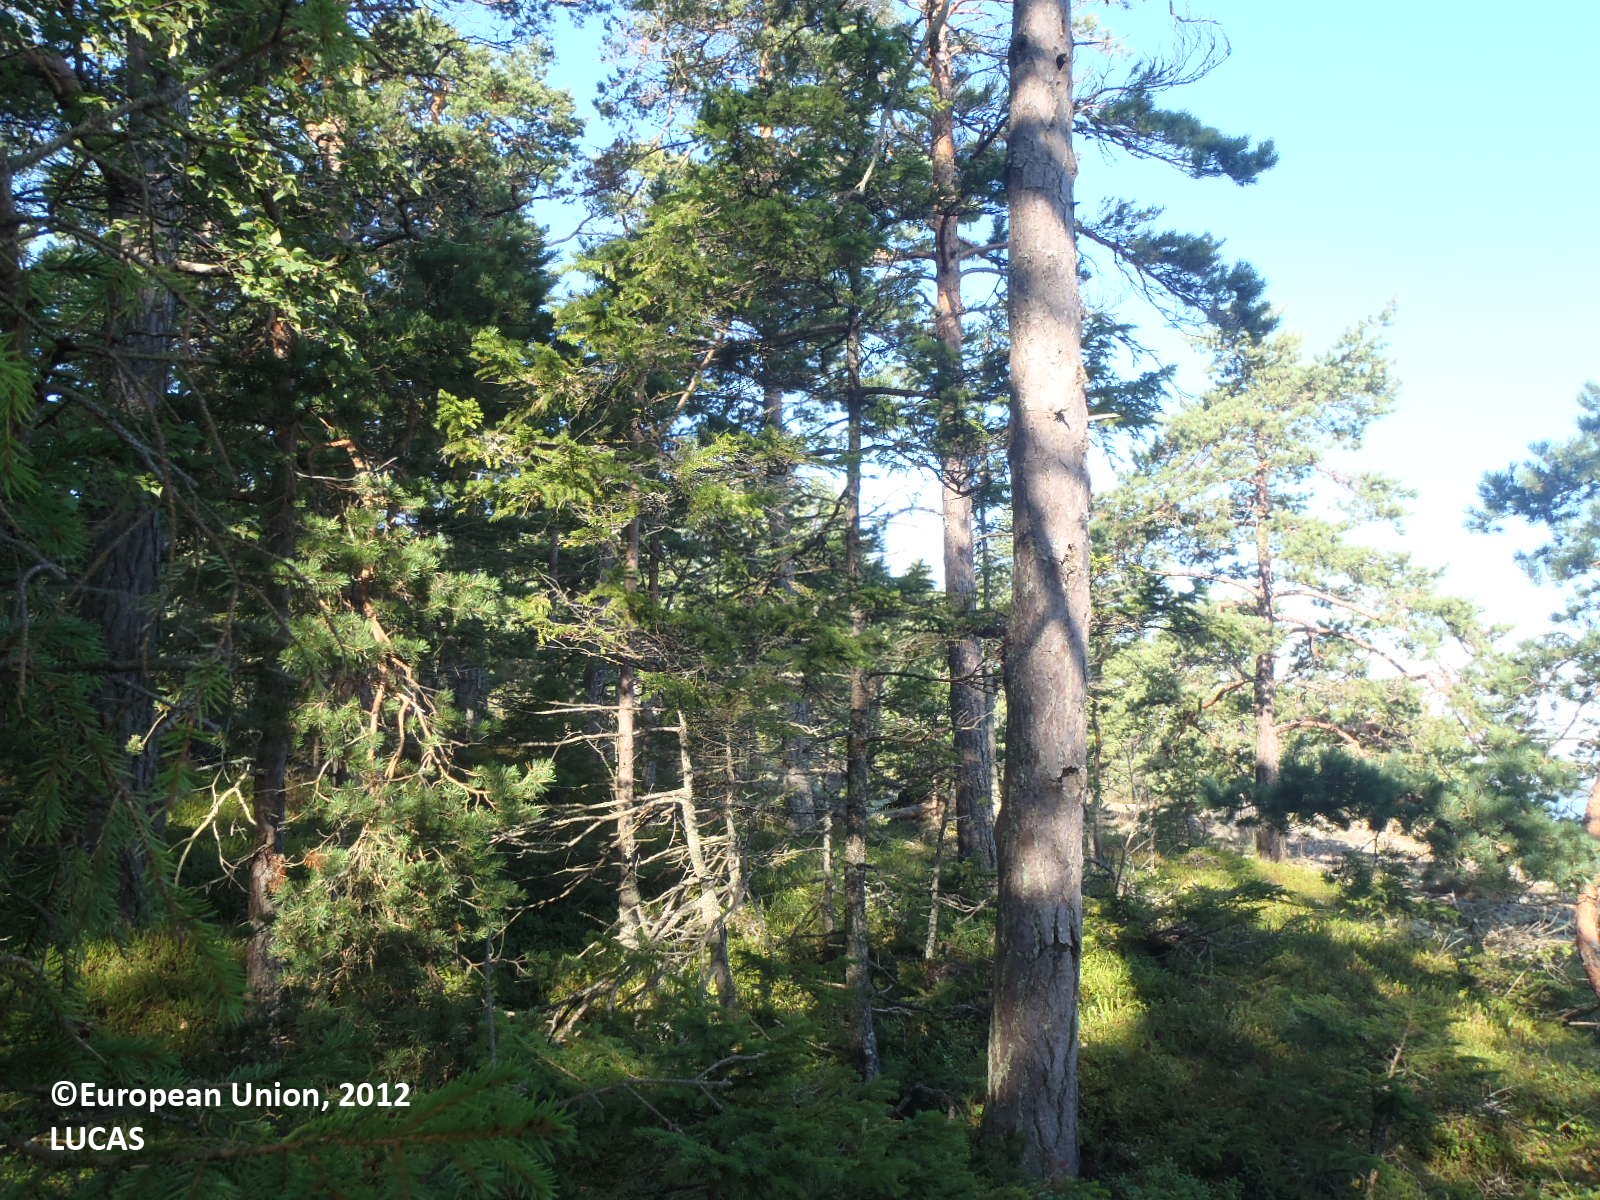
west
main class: Woodland
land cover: Pine dominated mixed woodland
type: hemiboreal forest and nemoral coniferous forest and mixed broadleaved-coniferous forest
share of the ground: 50 - 75 %
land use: Forestry
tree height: > 5 m
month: August
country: FI
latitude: 60.2222
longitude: 20.2804
